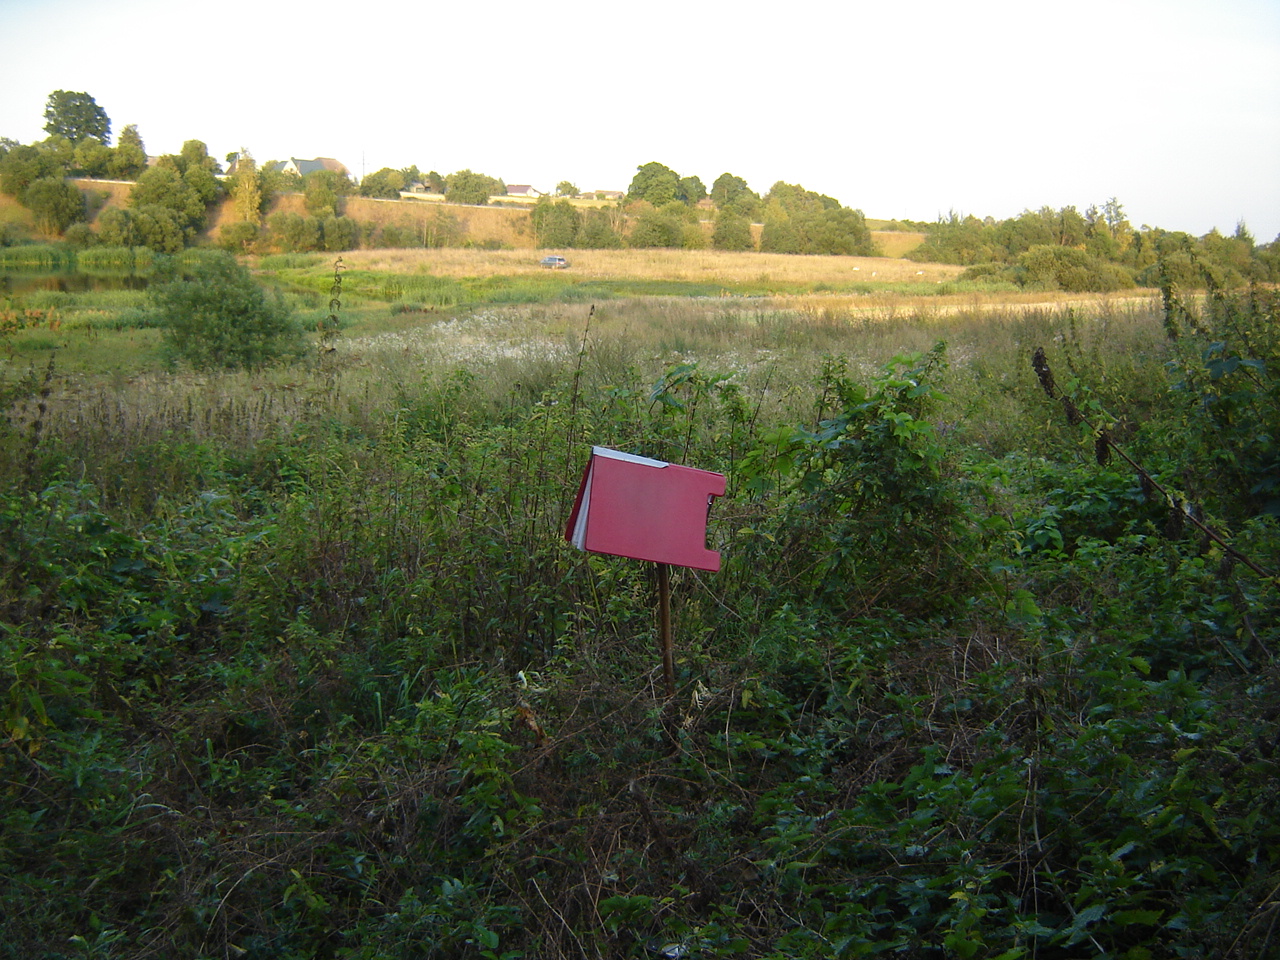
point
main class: Grassland
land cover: Spontaneously vegetated surfaces
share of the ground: > 75 %
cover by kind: herbaceous plants 100 %
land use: Semi-natural and natural areas not in use
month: August
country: LT
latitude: 54.7908
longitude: 24.8062
